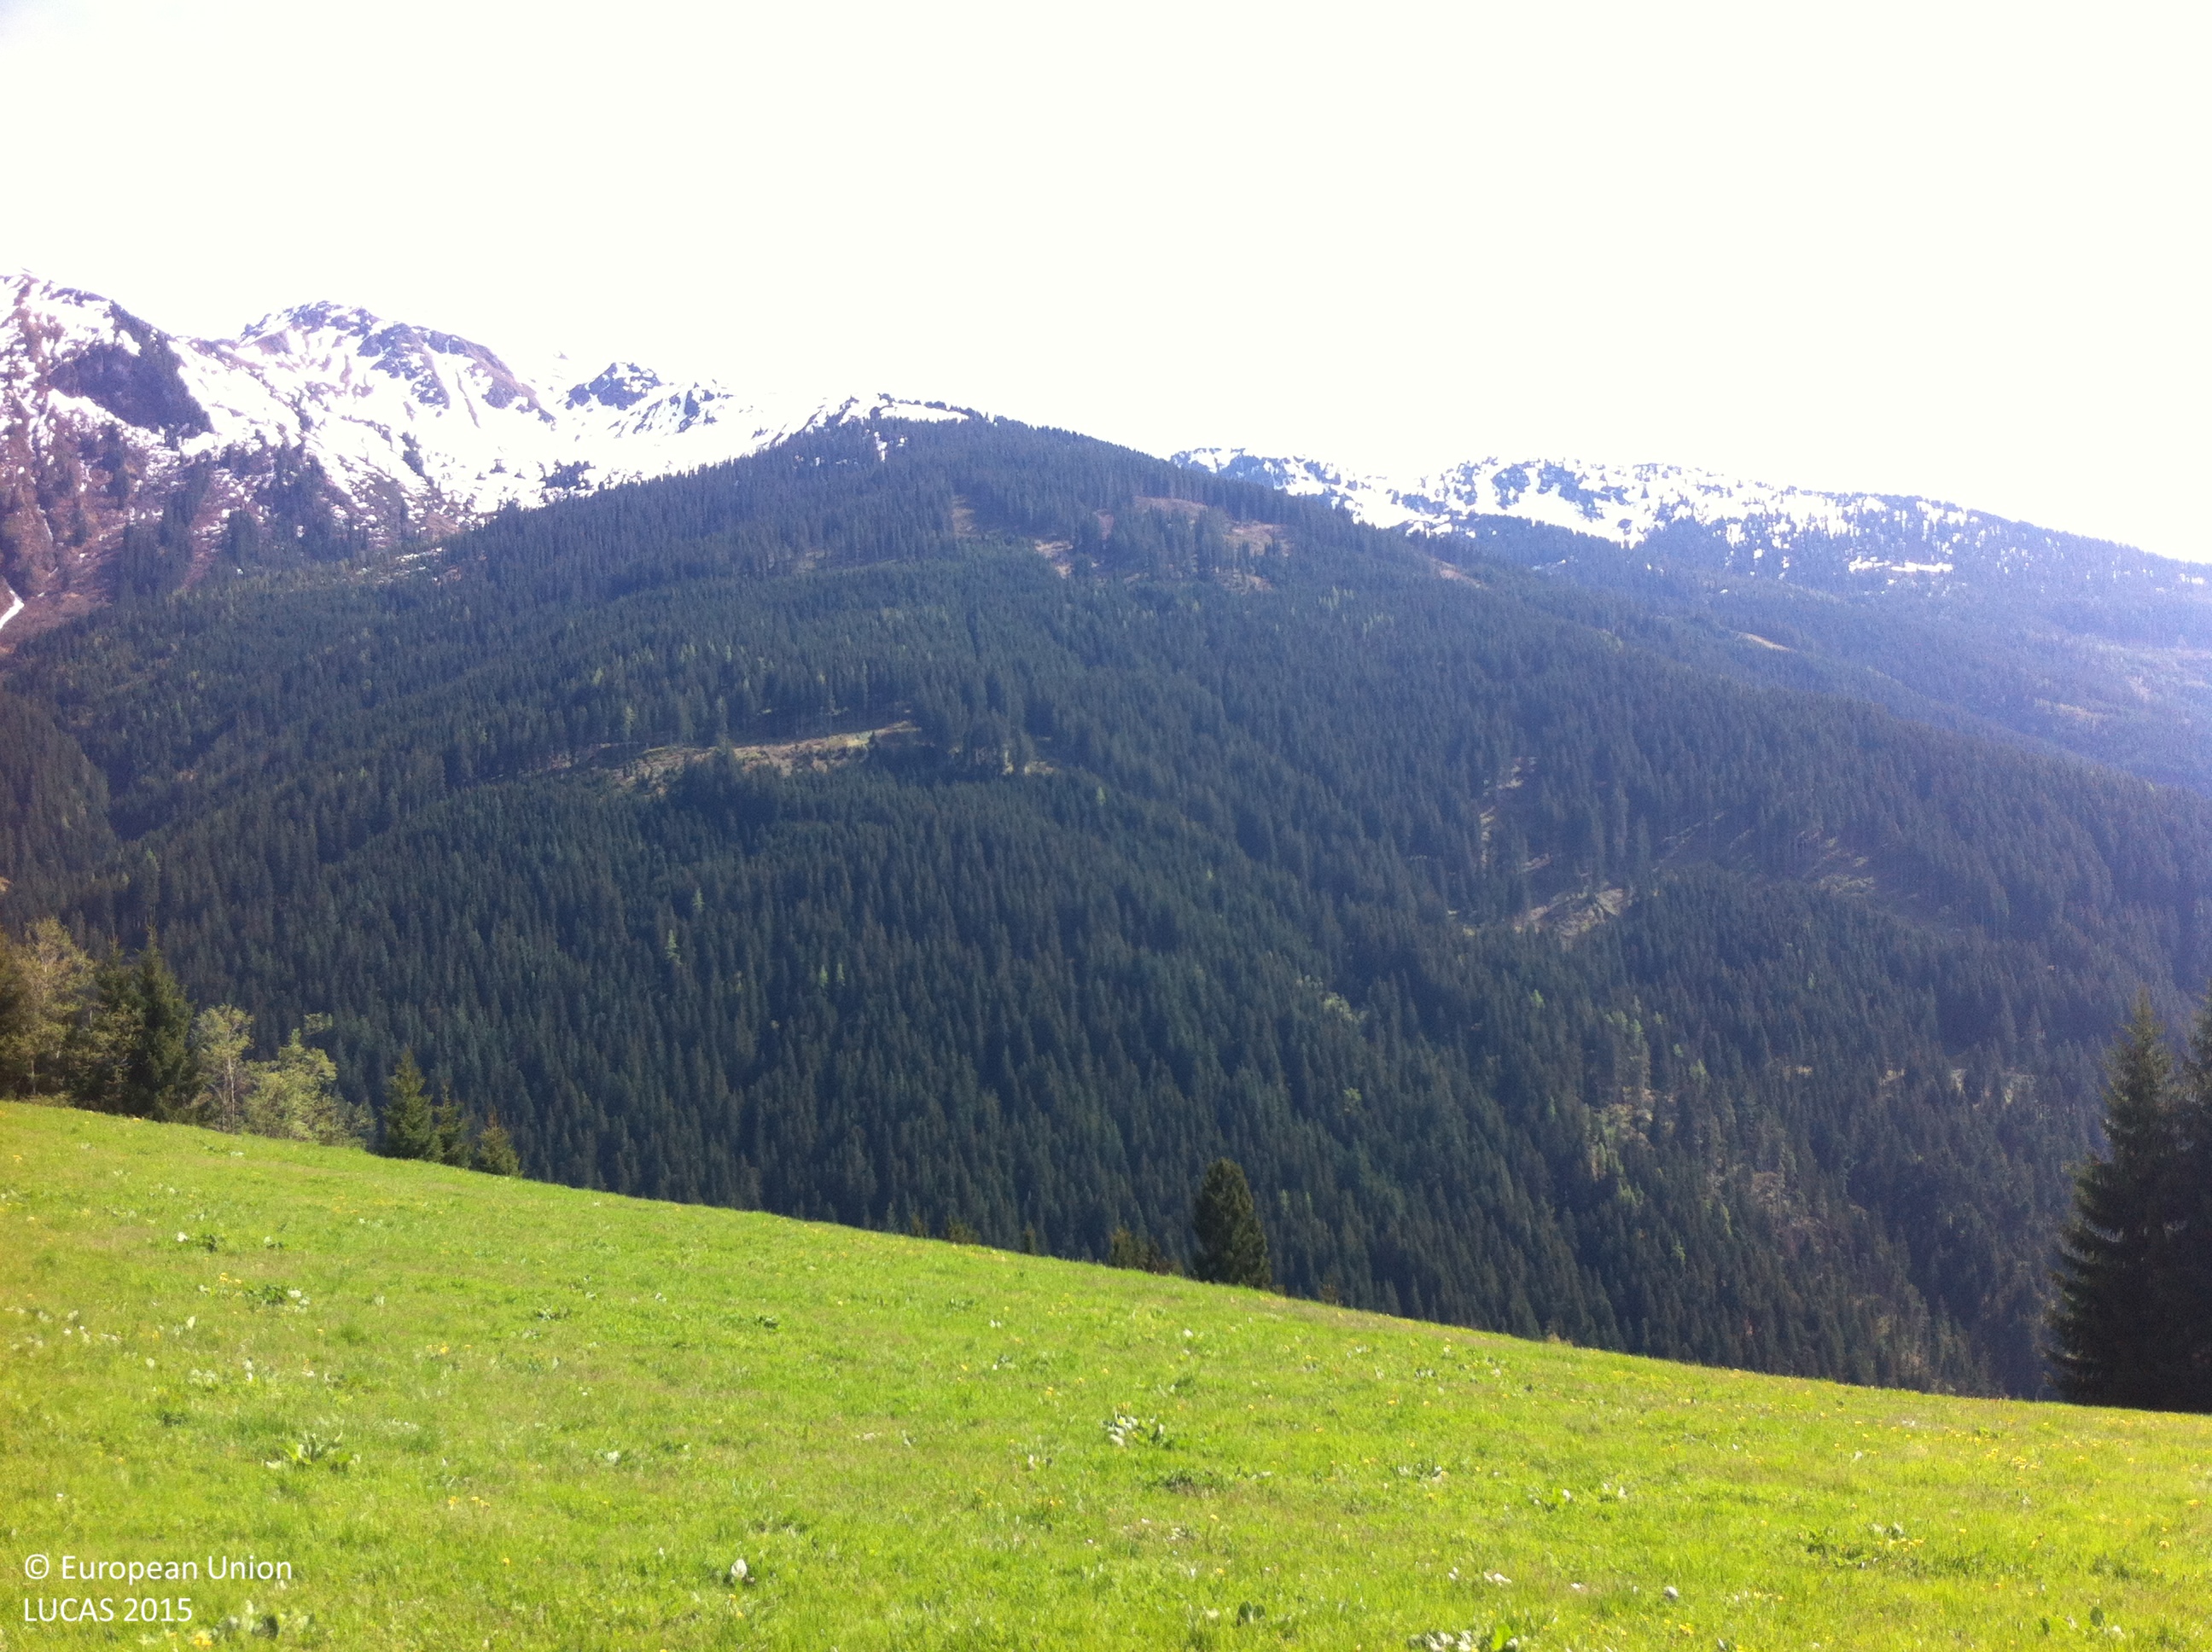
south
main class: Grassland
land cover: Grassland without tree/shrub cover
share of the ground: > 75 %
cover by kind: herbaceous plants 100 %
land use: Agriculture (excluding fallow land and kitchen gardens)
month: May
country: AT
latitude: 47.3098
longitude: 11.7313
